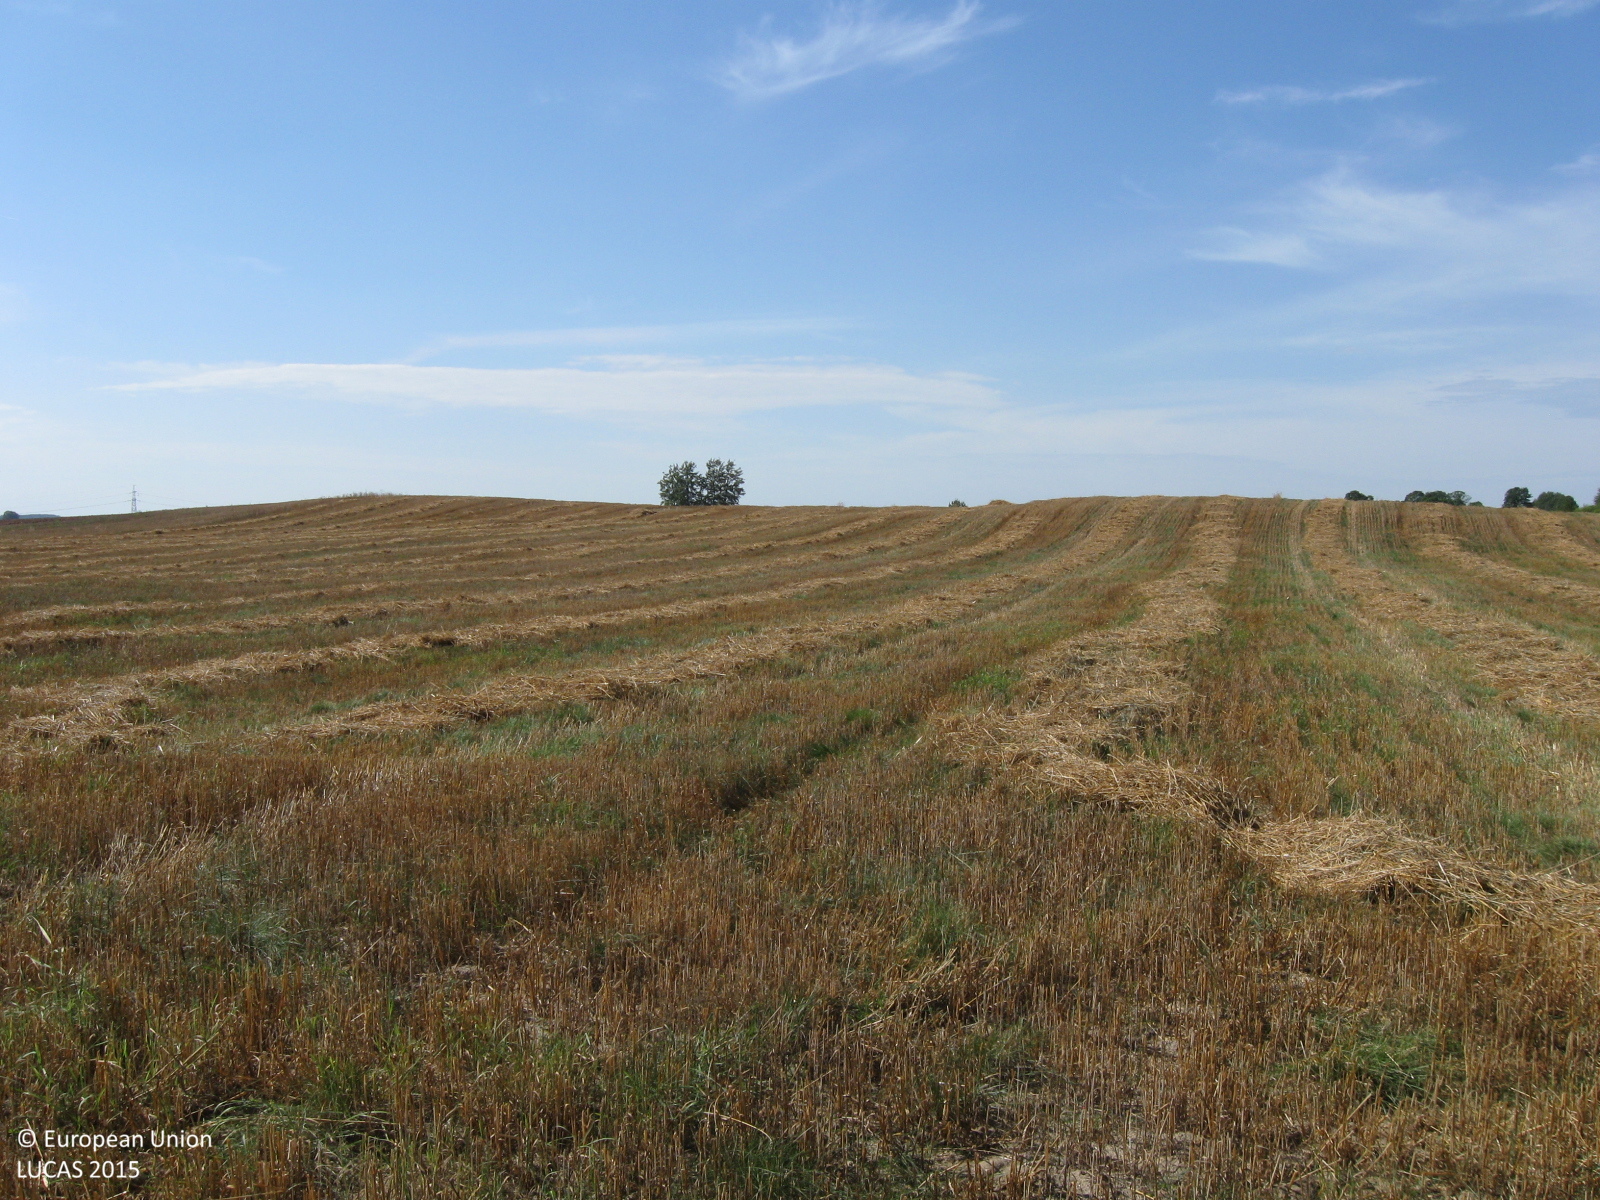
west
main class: Cropland
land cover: Common wheat
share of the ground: > 75 %
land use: Agriculture (excluding fallow land and kitchen gardens)
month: August
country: LT
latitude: 55.4537
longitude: 23.3103
